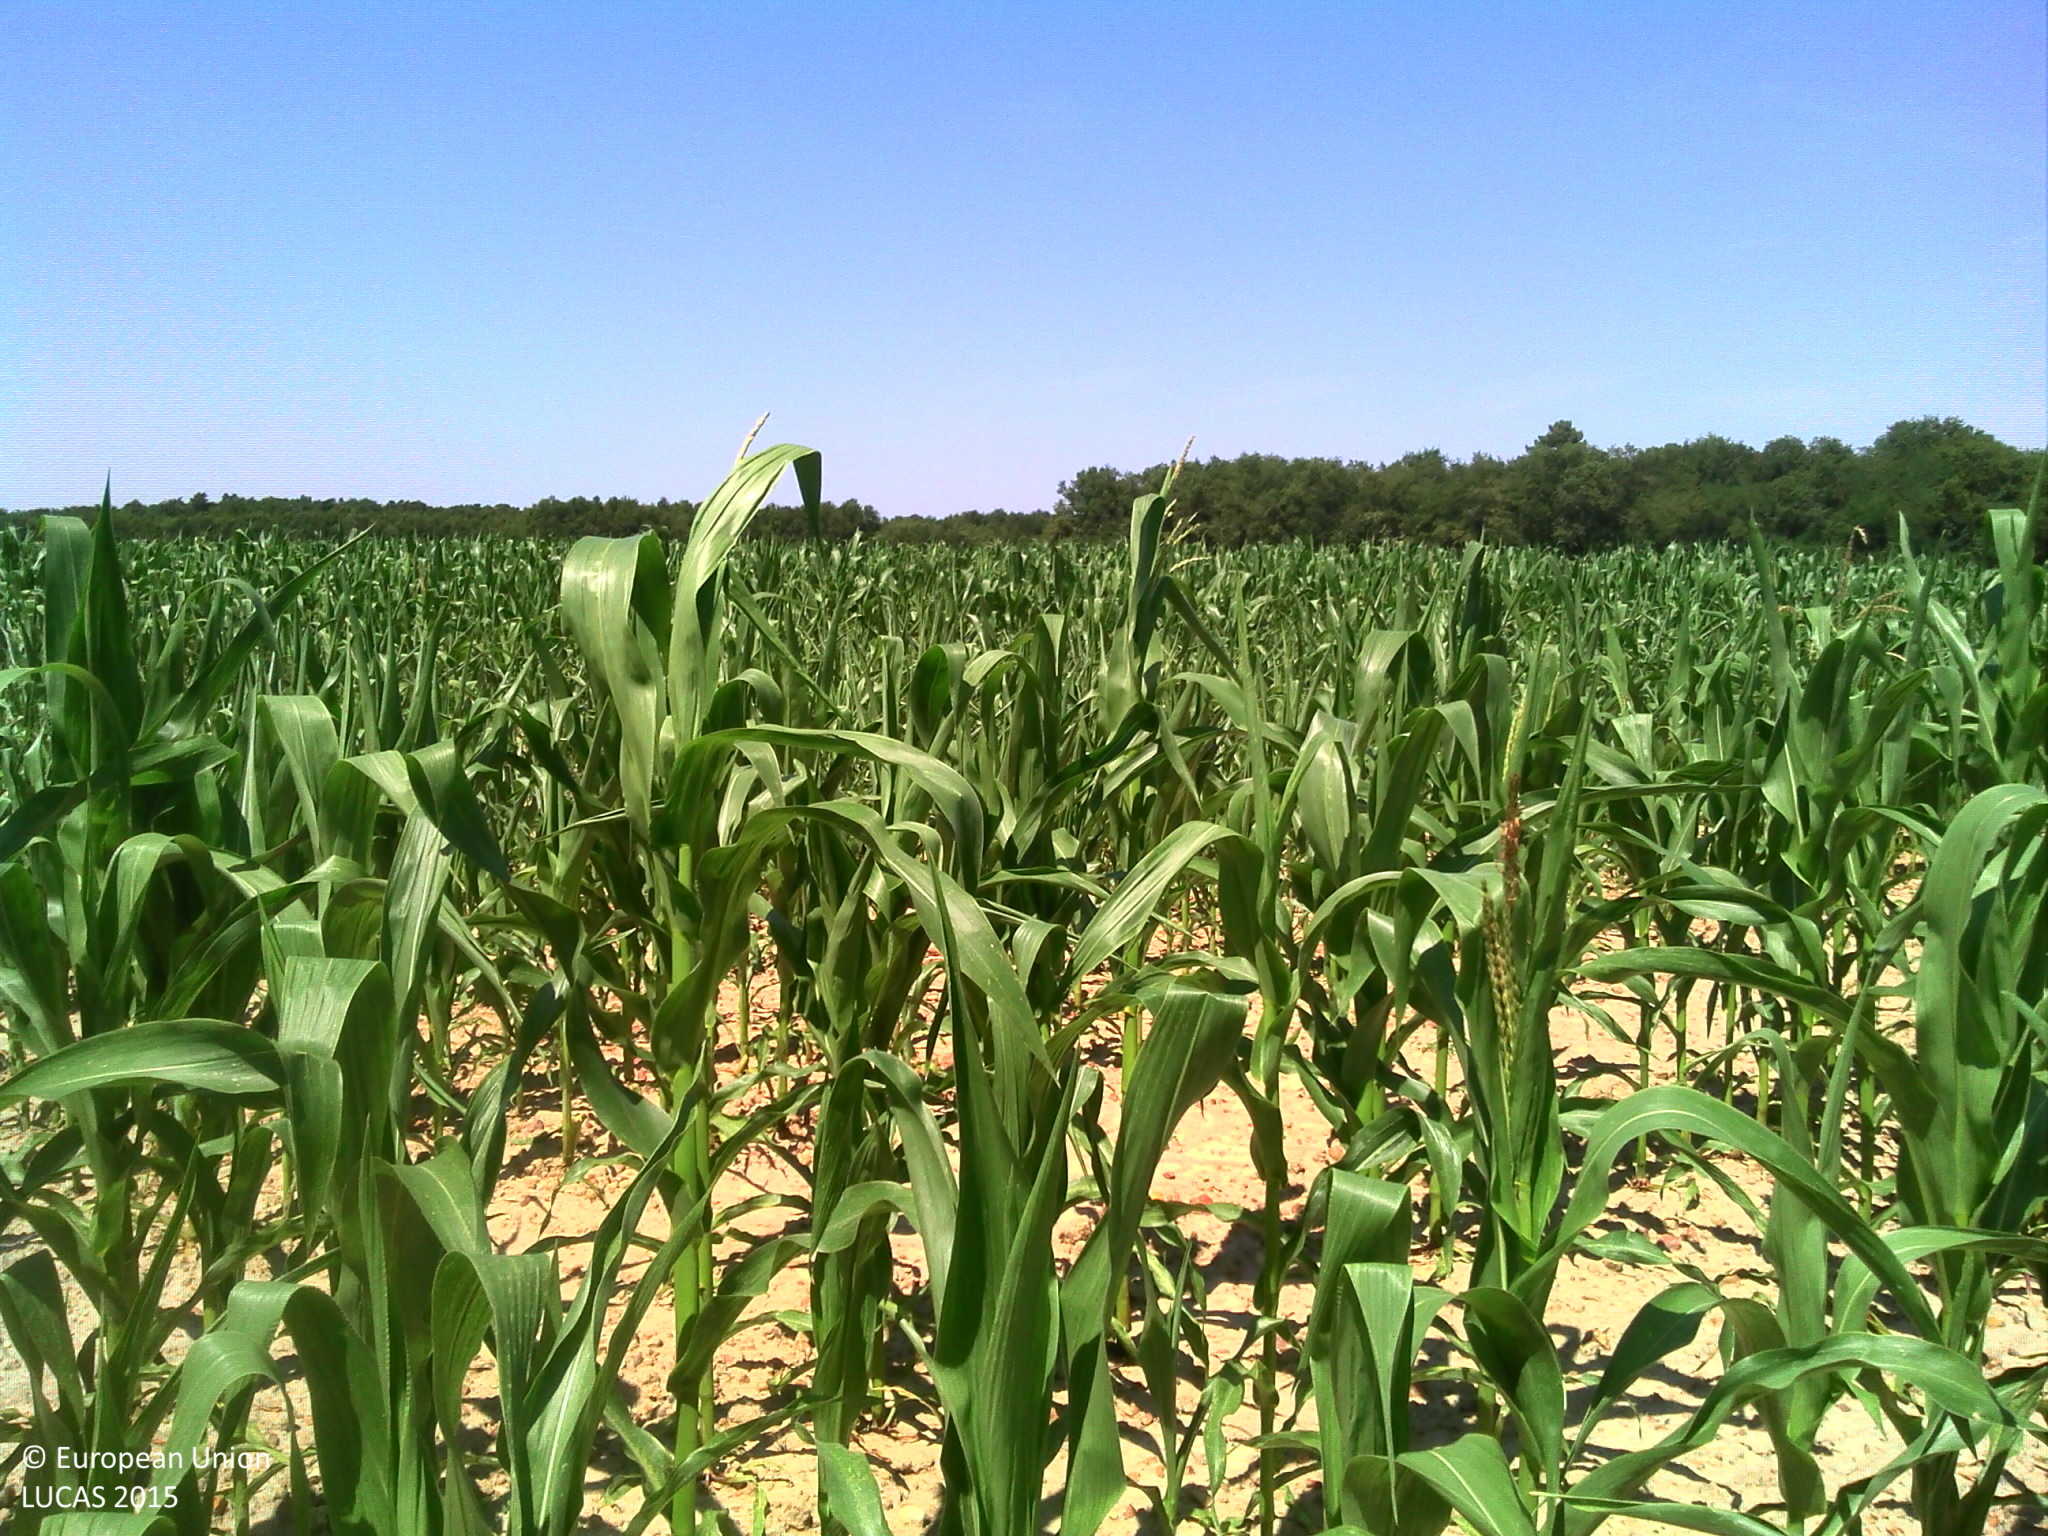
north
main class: Cropland
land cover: Maize
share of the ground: 25 - 50 %
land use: Agriculture (excluding fallow land and kitchen gardens)
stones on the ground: 10 - 25 %
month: July
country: FR
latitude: 47.2182
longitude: 0.7515
